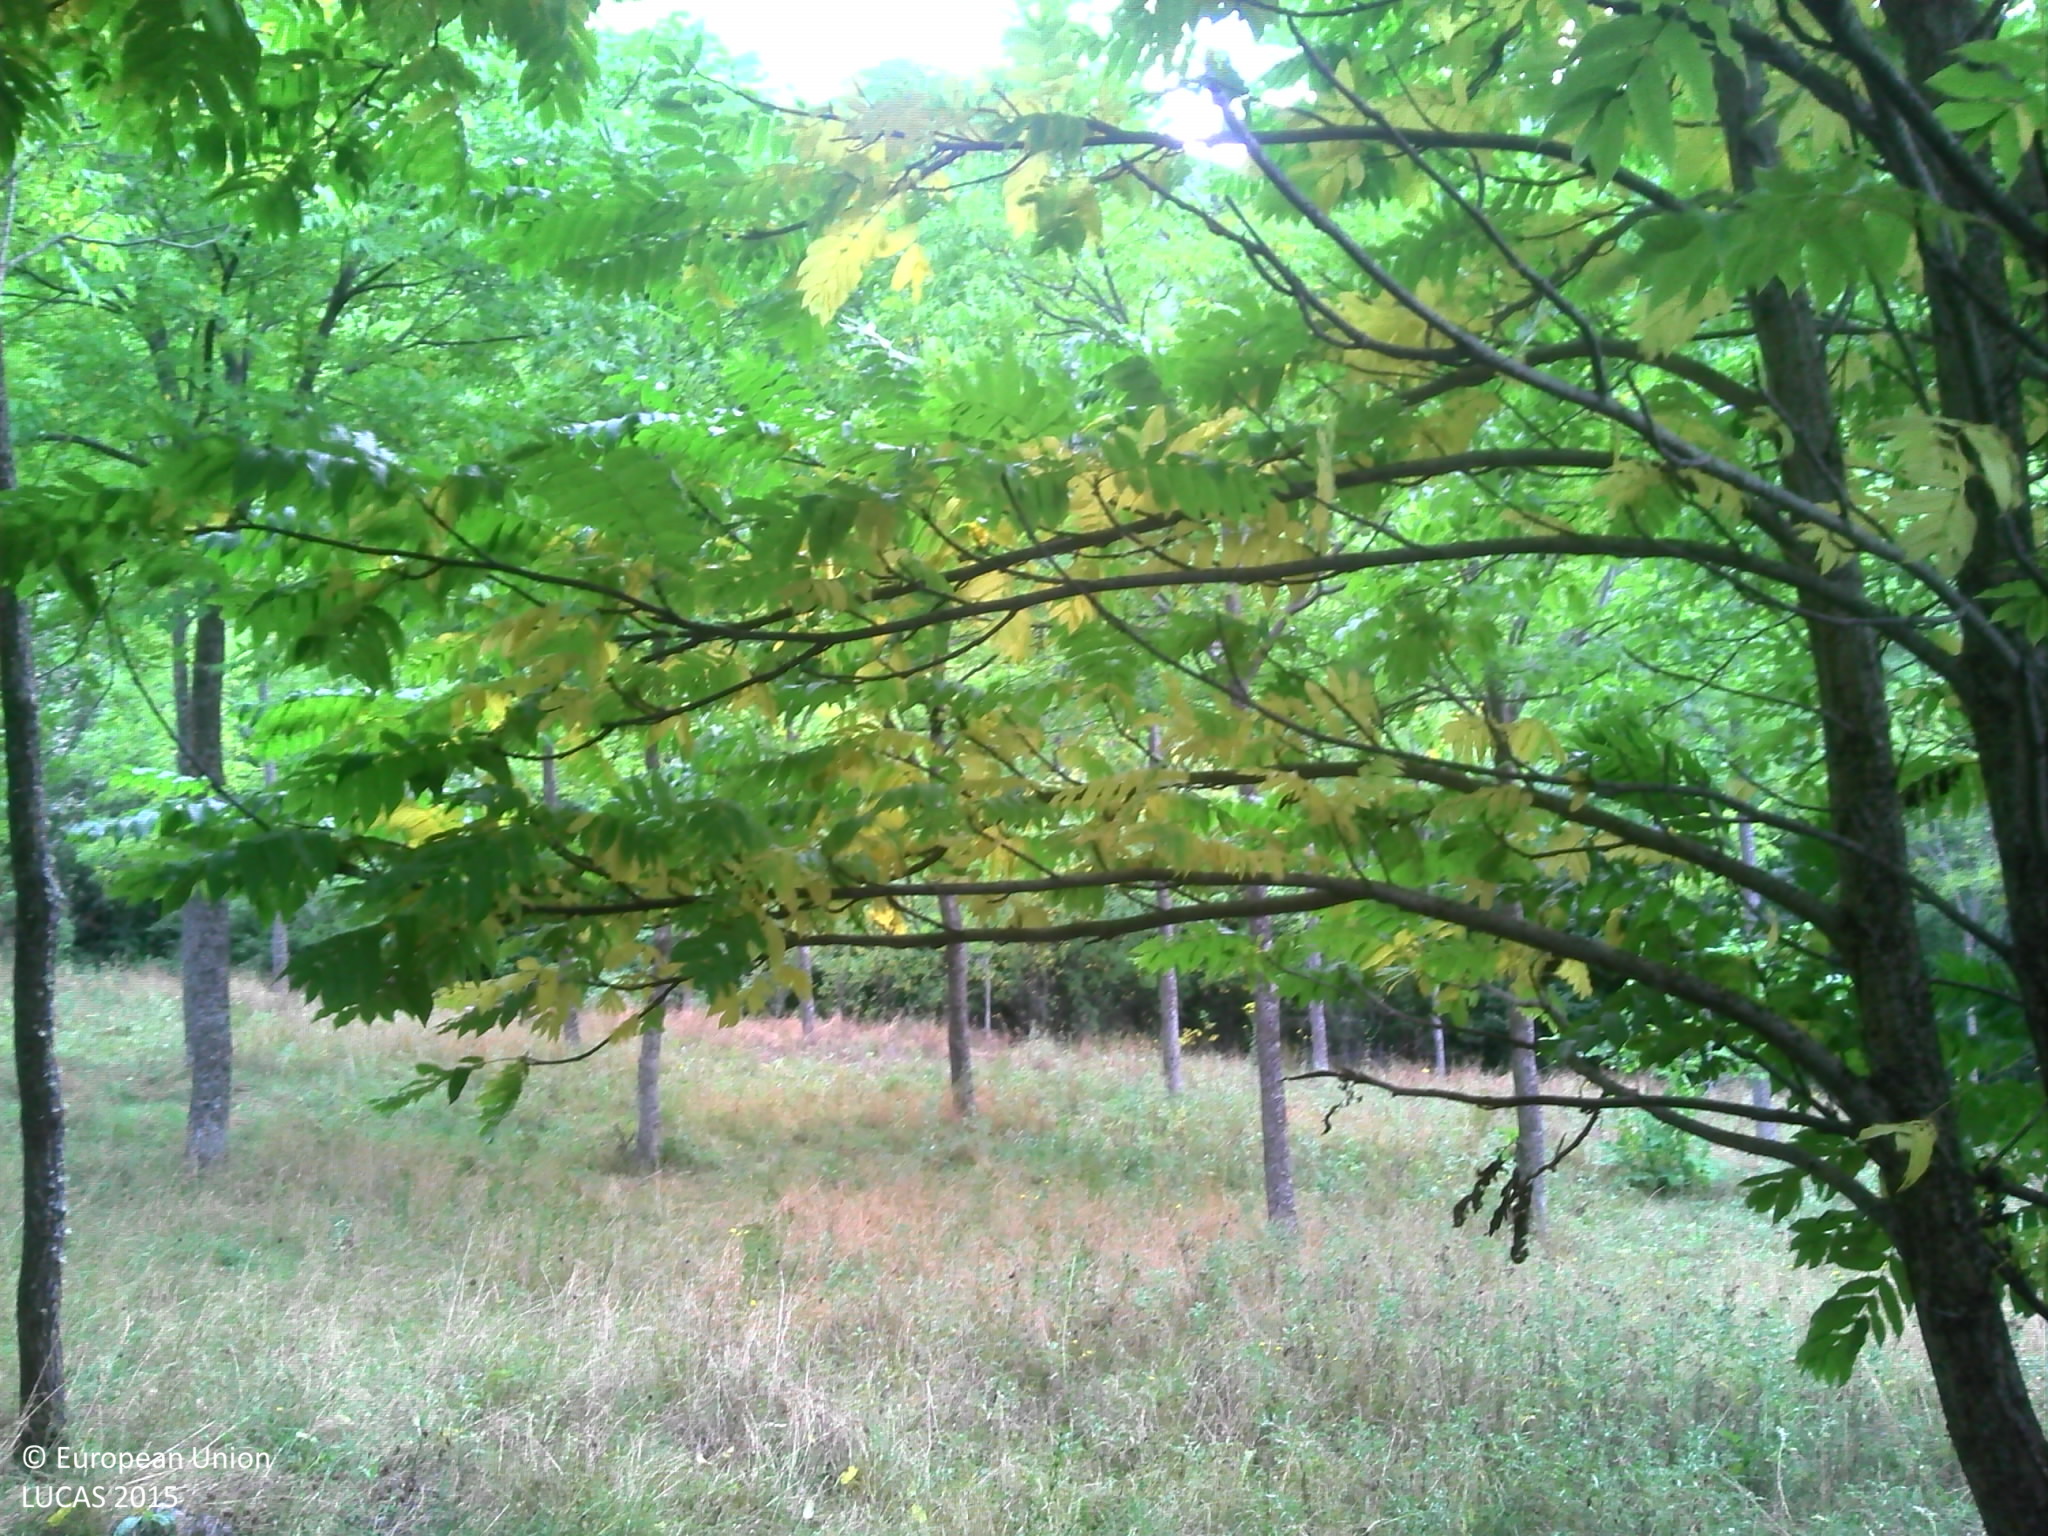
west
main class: Cropland
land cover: Nuts trees
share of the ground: 50 - 75 %
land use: Agriculture (excluding fallow land and kitchen gardens)
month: September
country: FR
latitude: 44.4346
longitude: 5.5222
